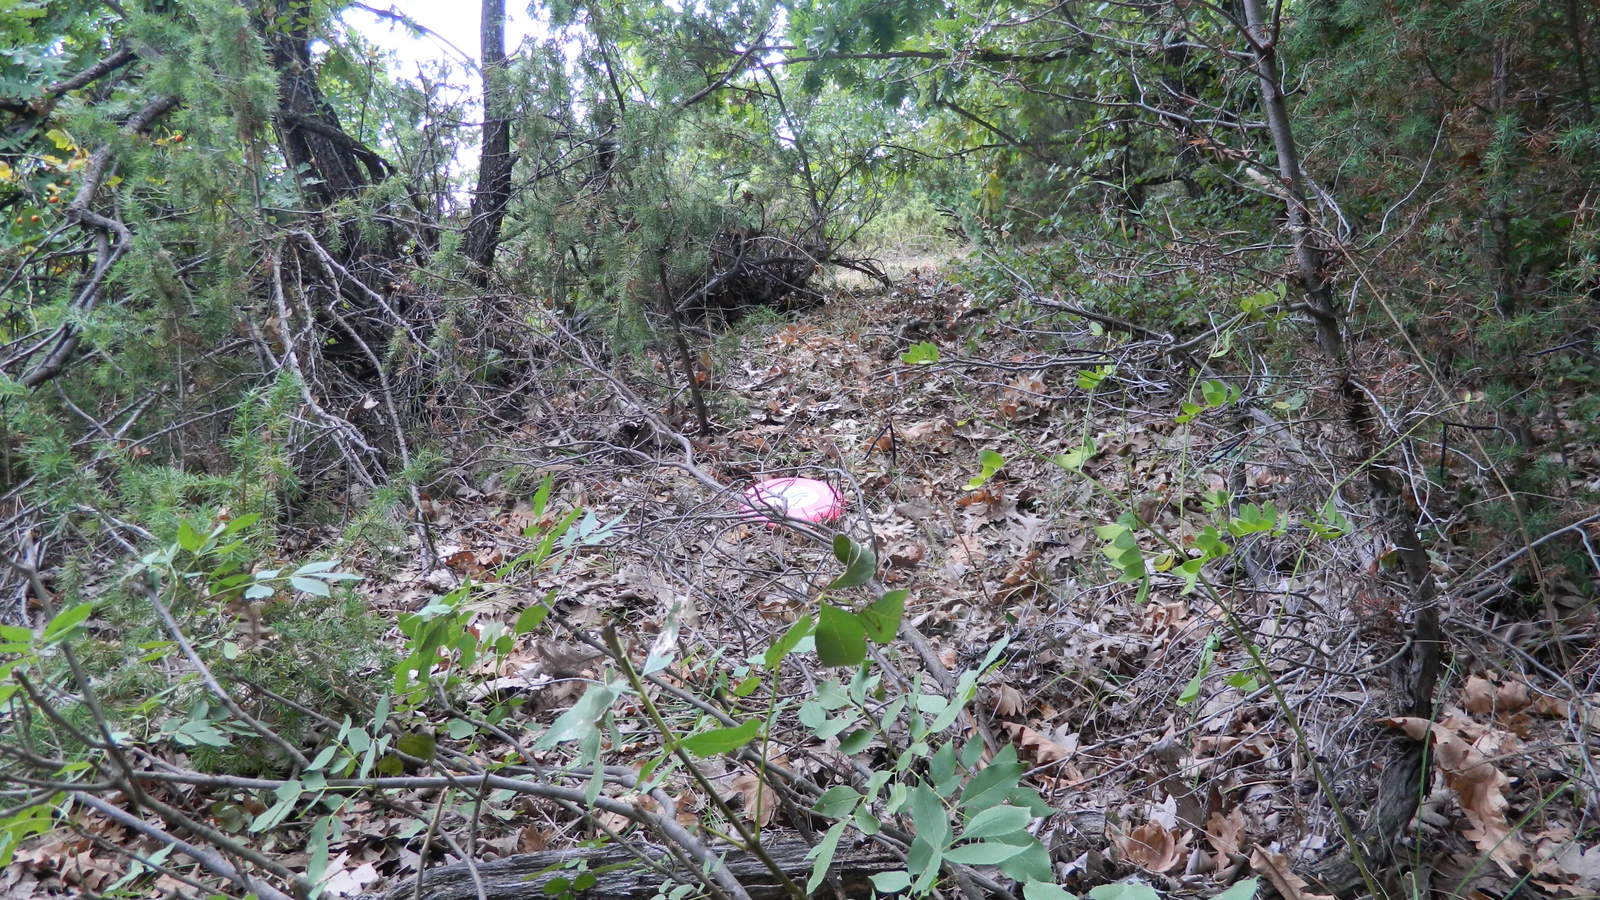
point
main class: Woodland
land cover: Broadleaved woodland
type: mesophytic deciduous forest
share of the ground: > 75 %
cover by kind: broadleaved forest trees 80 %, unconsolidated bare surface 15 %, shrubs 5 %
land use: Forestry
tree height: > 5 m
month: August
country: BG
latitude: 41.6956
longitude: 25.8192
